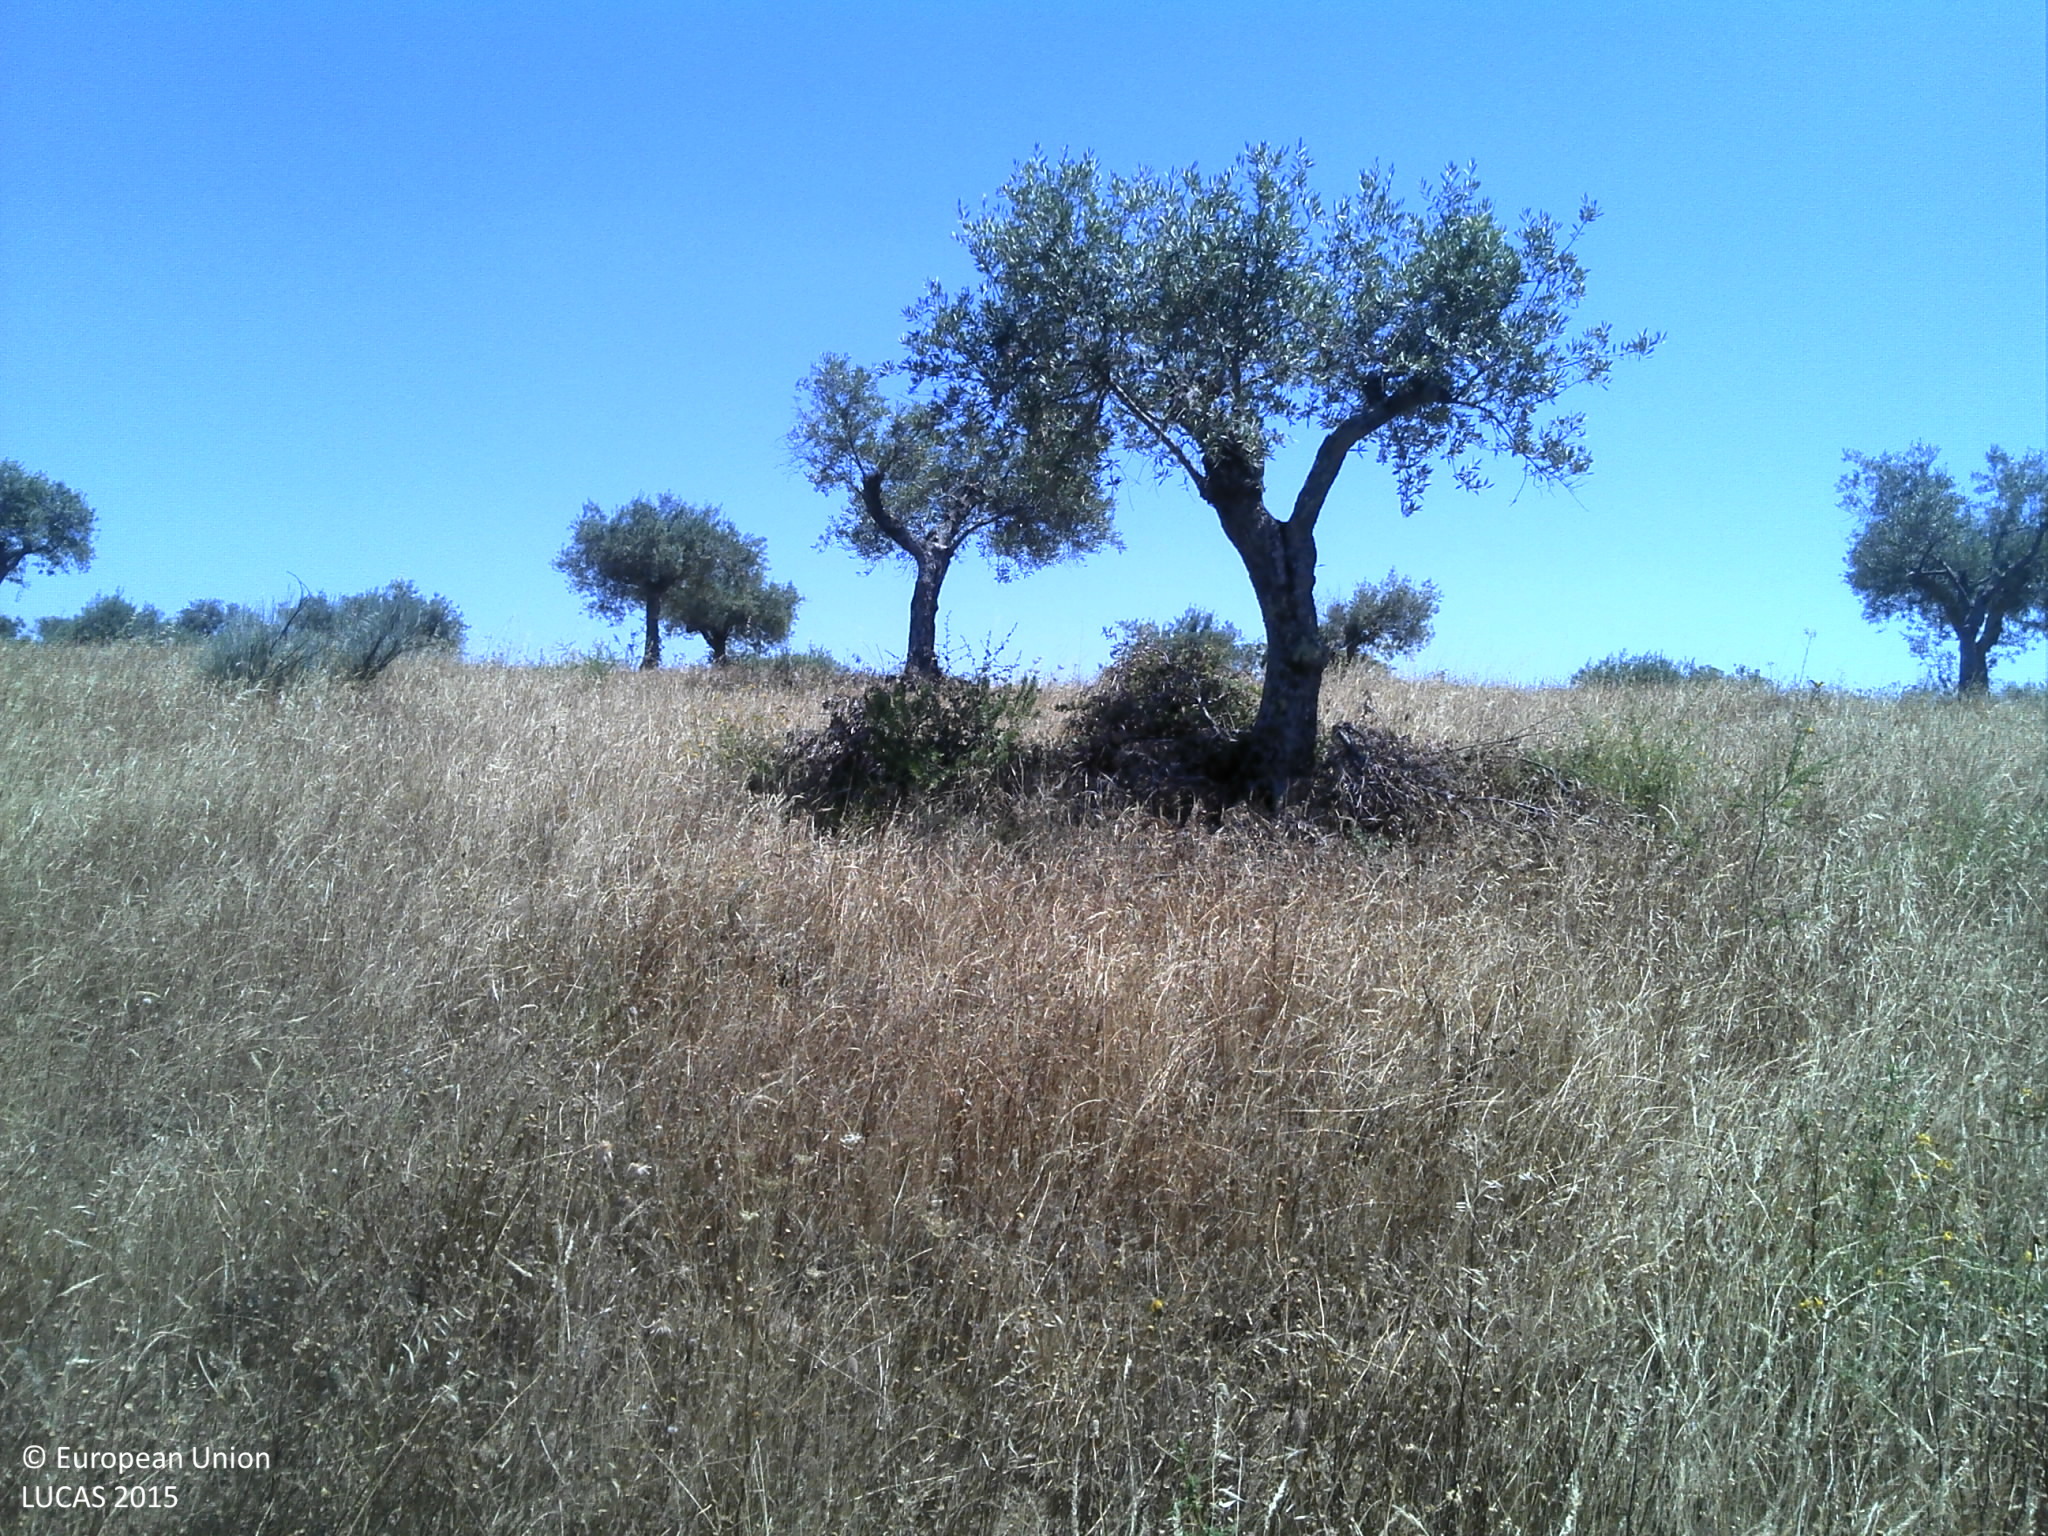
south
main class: Cropland
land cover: Olive groves
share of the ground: 25 - 50 %
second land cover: Grassland without tree/shrub cover
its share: 50 - 75 %
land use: Agriculture (excluding fallow land and kitchen gardens)
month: June
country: PT
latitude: 40.0322
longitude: -7.1692
